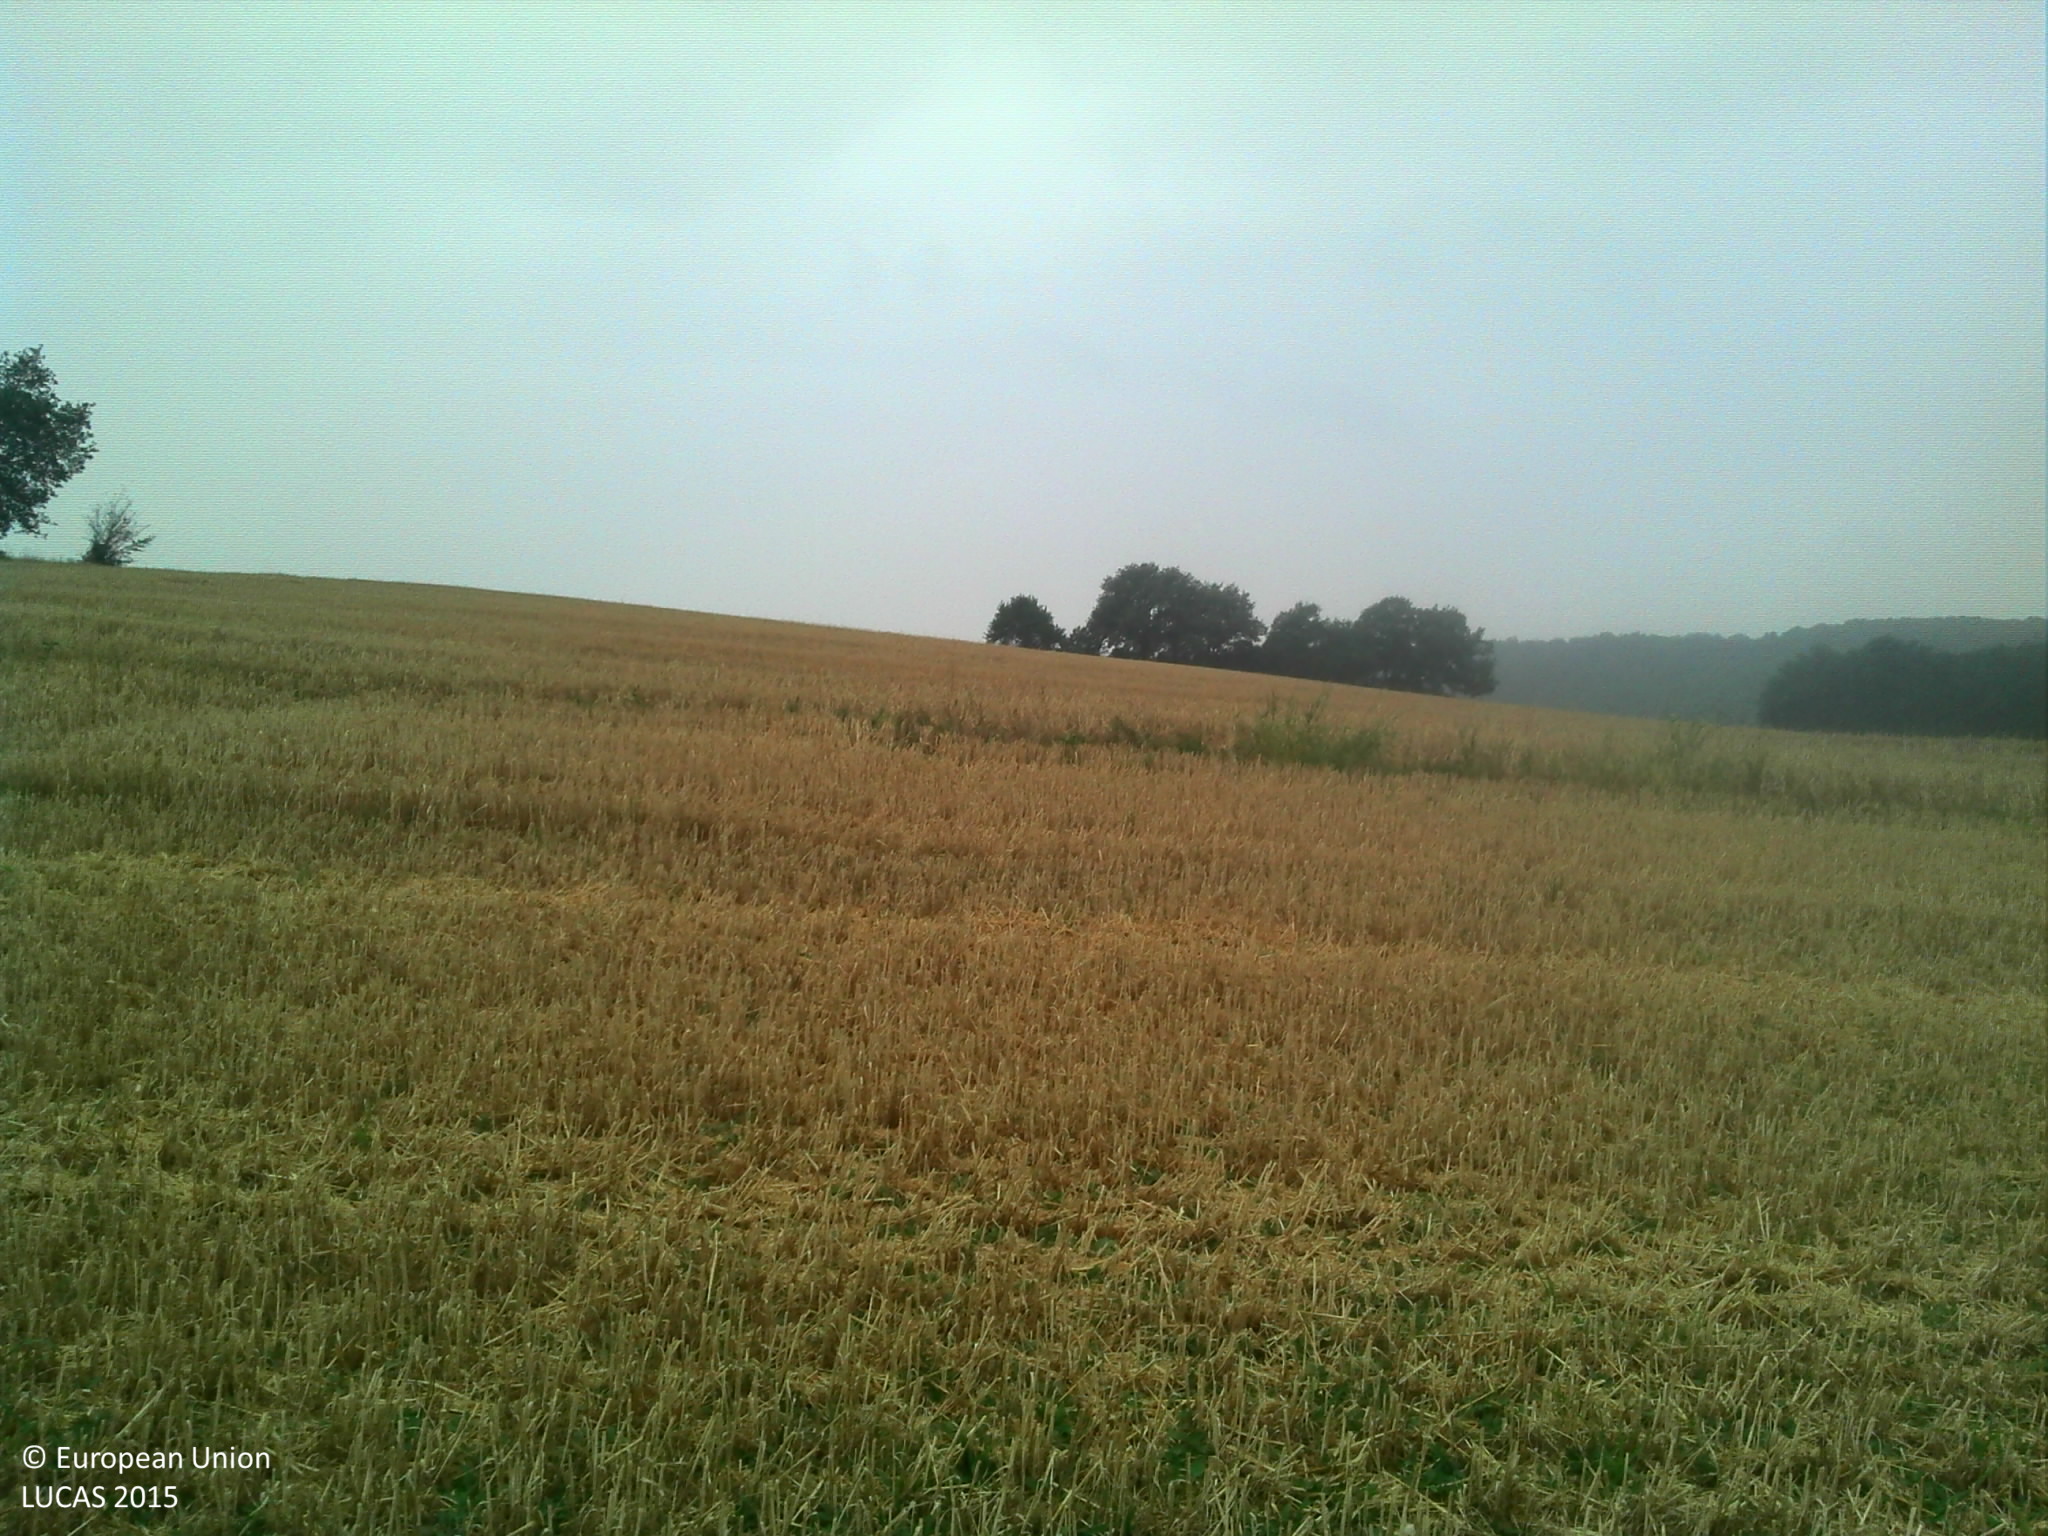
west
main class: Cropland
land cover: Common wheat
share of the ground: > 75 %
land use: Agriculture (excluding fallow land and kitchen gardens)
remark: Harvested field
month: July
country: FR
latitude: 43.9670
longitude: 0.8865
